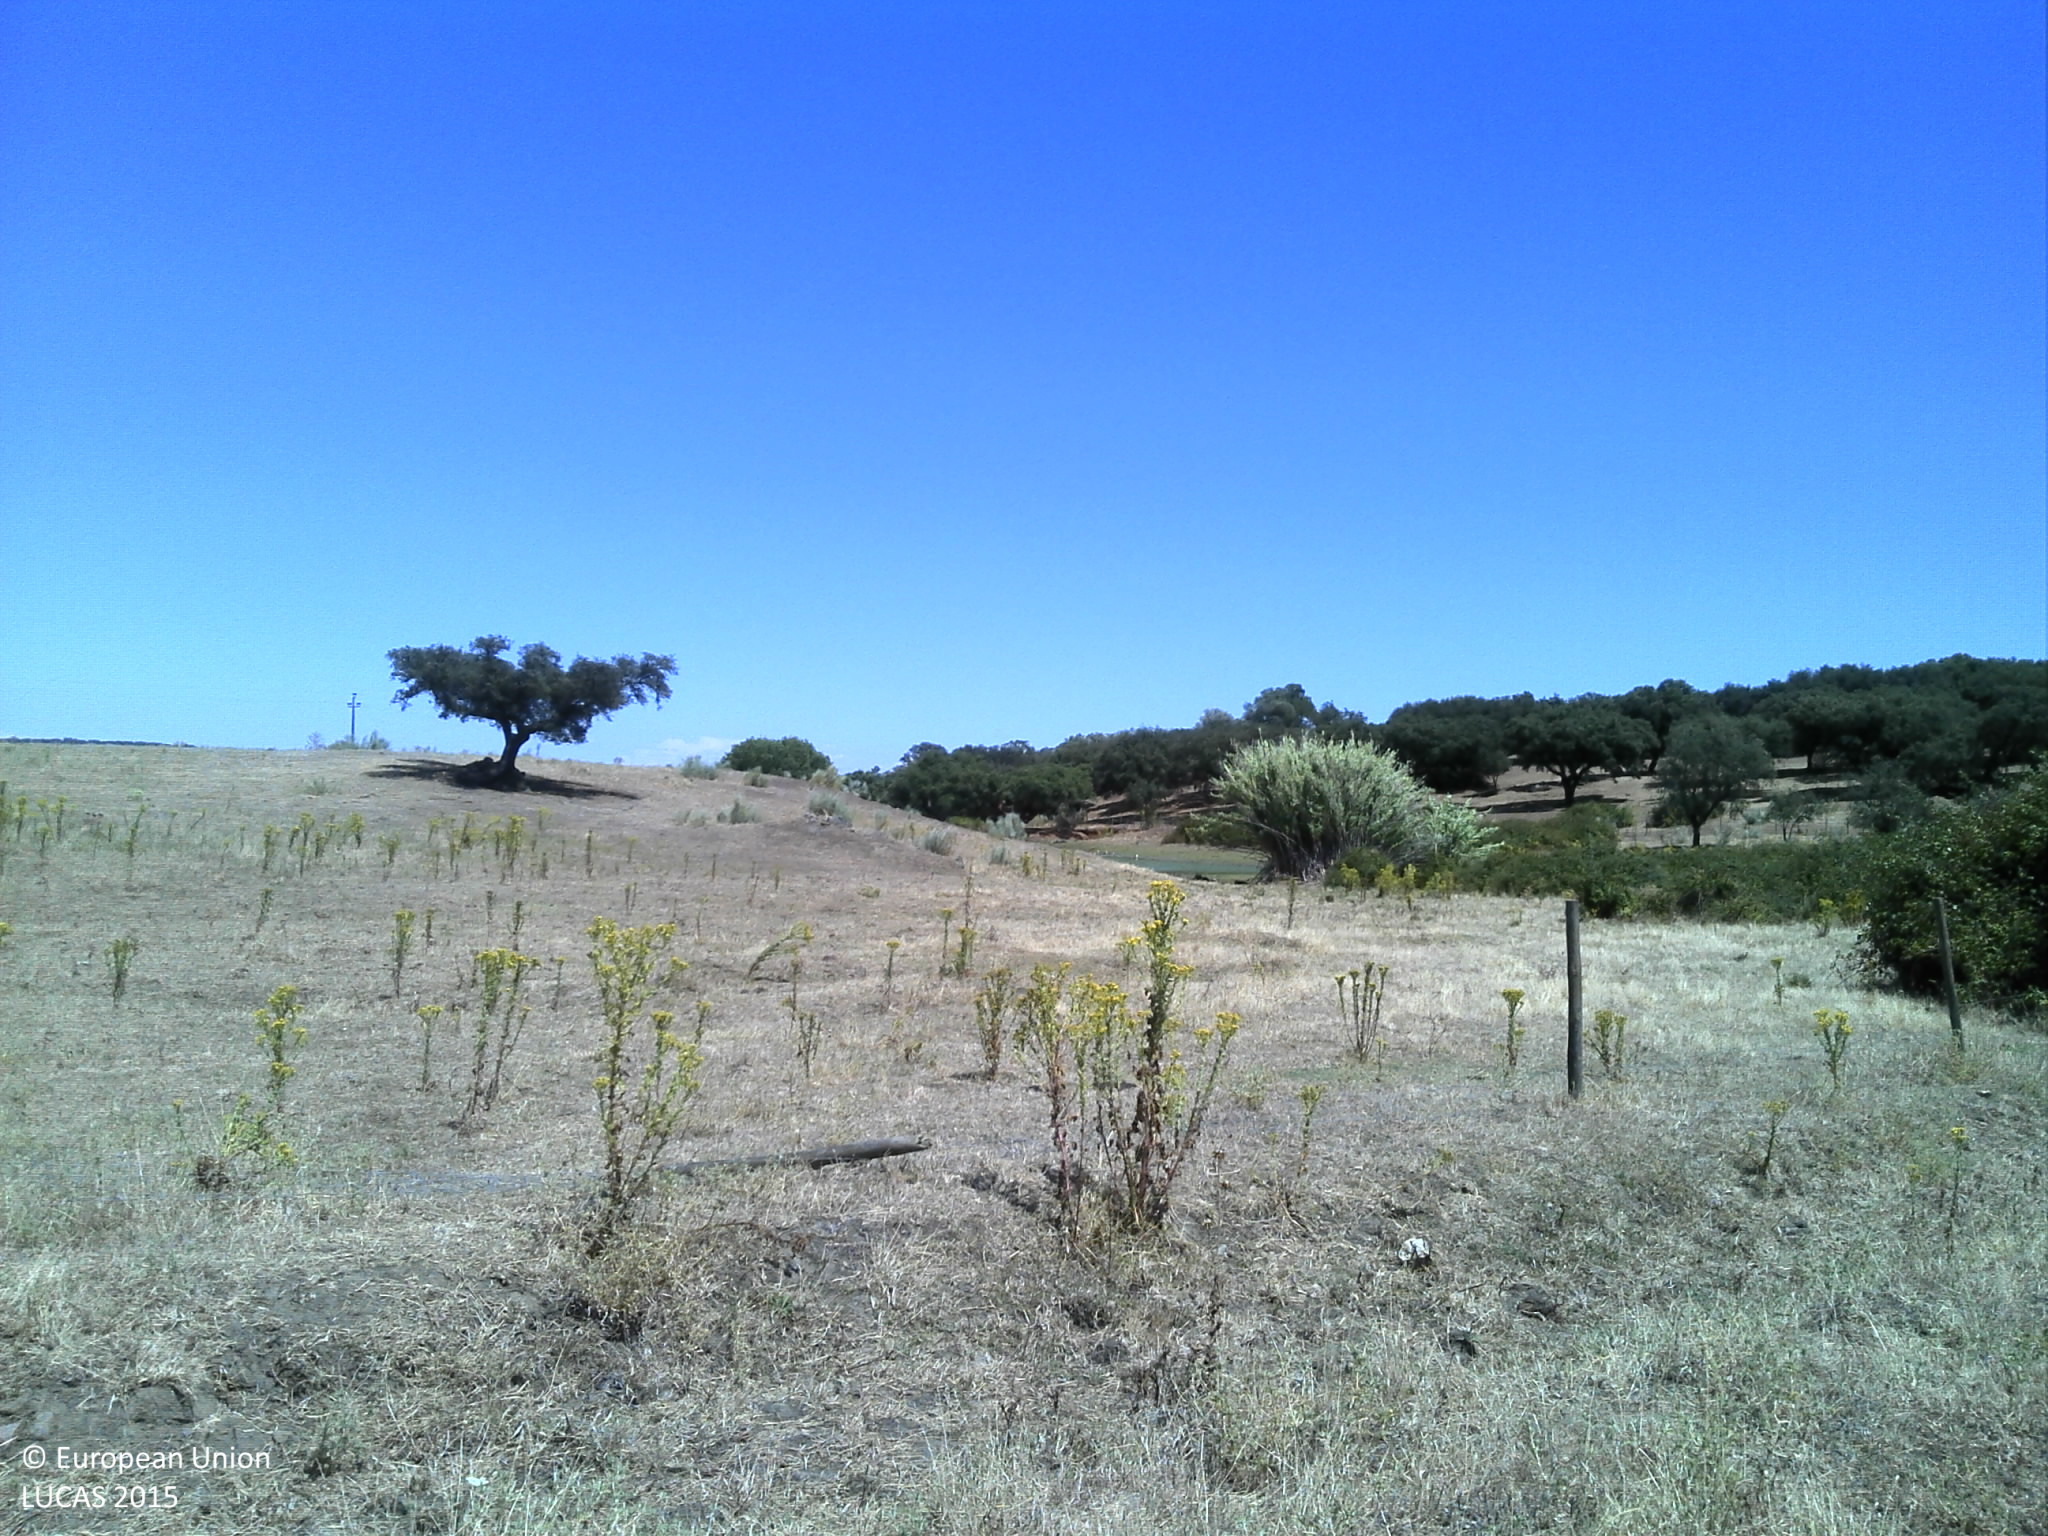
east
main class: Grassland
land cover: Grassland without tree/shrub cover
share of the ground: 25 - 50 %
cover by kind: unconsolidated bare surface 75 %, herbaceous plants 25 %
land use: Agriculture (excluding fallow land and kitchen gardens)
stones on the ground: < 10 %
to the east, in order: Grassland without tree/shrub cover; Ditches and canals; Fences; Grassland without tree/shrub cover; Inland fresh water bodies; Broadleaved woodland; Ditches and canals; Fences; Broadleaved woodland
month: July
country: PT
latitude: 38.9809
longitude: -7.5739
